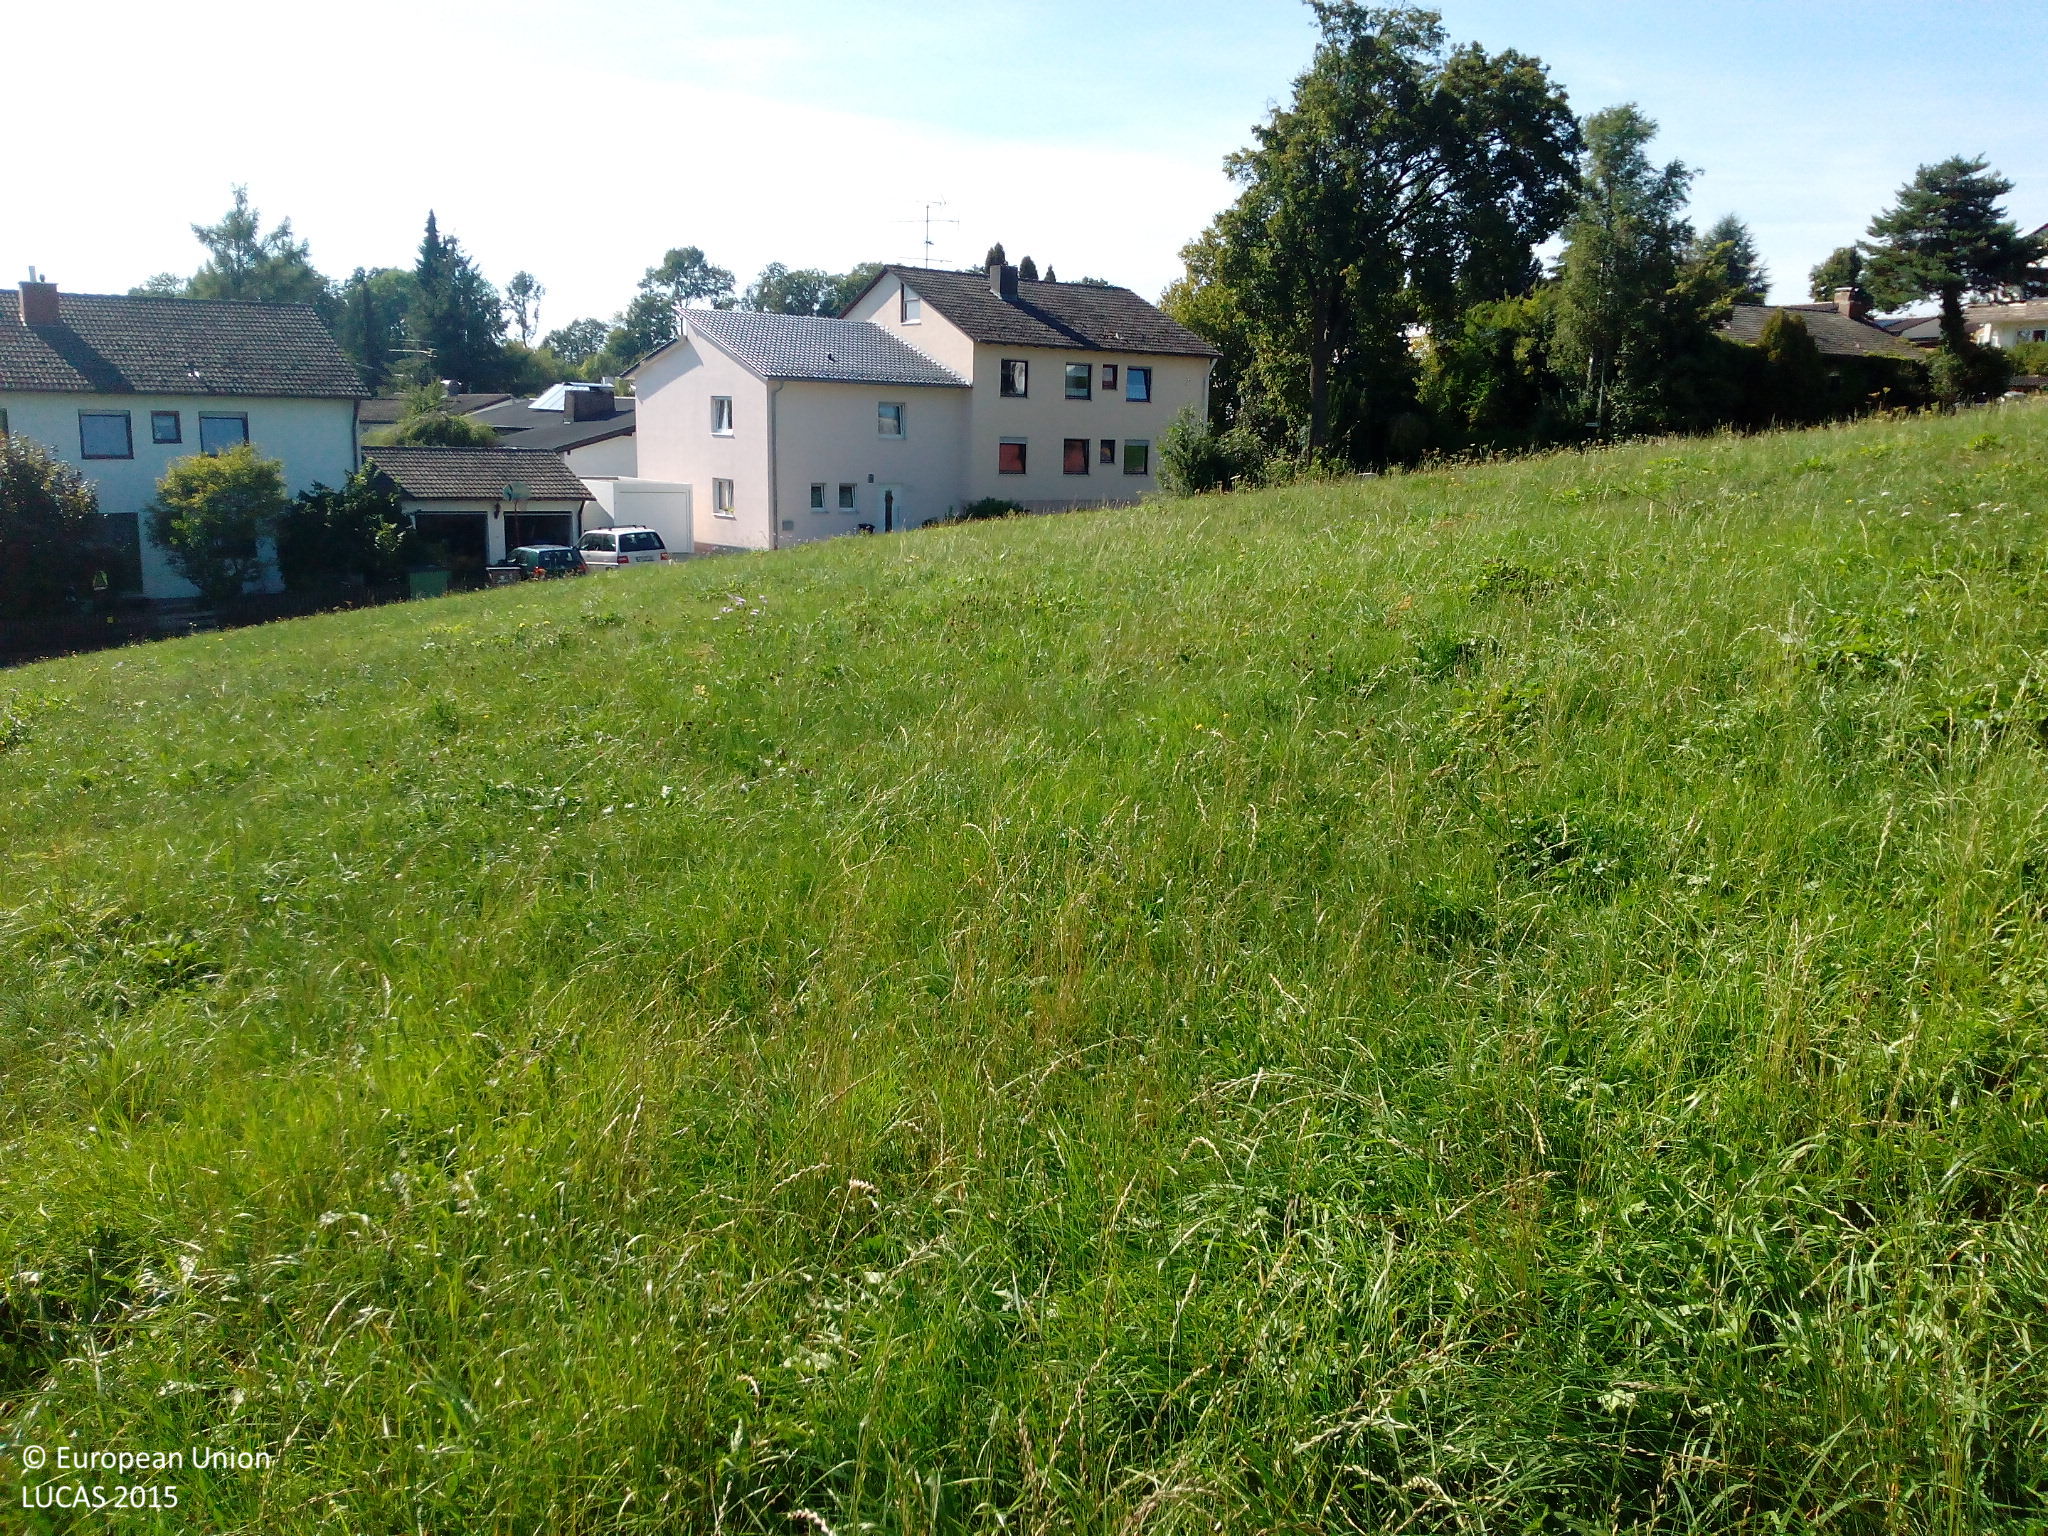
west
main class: Grassland
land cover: Grassland without tree/shrub cover
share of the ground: > 75 %
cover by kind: herbaceous plants 90 %, unconsolidated bare surface 10 %
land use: Agriculture (excluding fallow land and kitchen gardens)
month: September
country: DE
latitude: 48.3811
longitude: 10.9851
